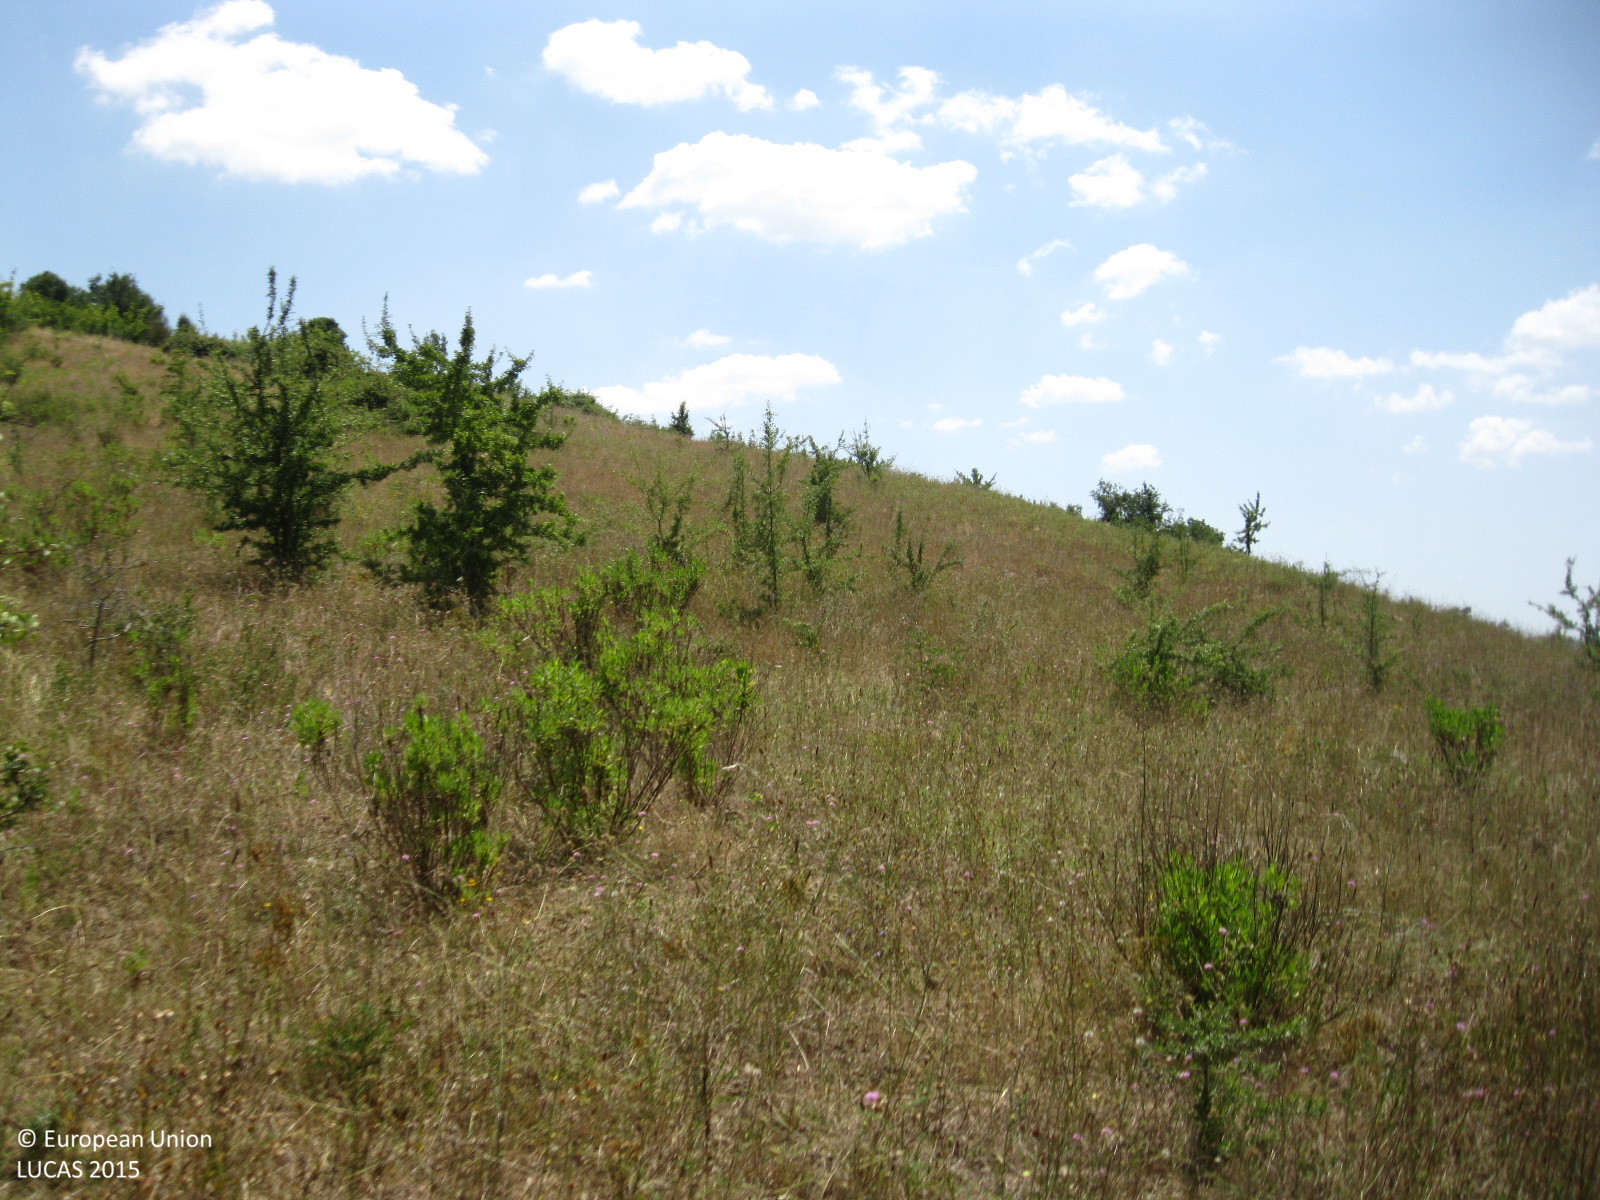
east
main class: Woodland
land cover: Broadleaved woodland
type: thermophilous deciduous forest
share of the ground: > 75 %
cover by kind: broadleaved forest trees 70 %, shrubs 25 %, herbaceous plants 5 %
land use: Forestry
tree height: > 5 m
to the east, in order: Broadleaved woodland; Rivers and streams; Shrubland with sparse tree cover; Grassland with sparse tree/shrub cover; Shrubland with sparse tree cover; Broadleaved woodland; Tracks; Shrubland with sparse tree cover; Mixed cereals for fodder
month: July
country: IT
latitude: 42.6795
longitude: 11.4718
